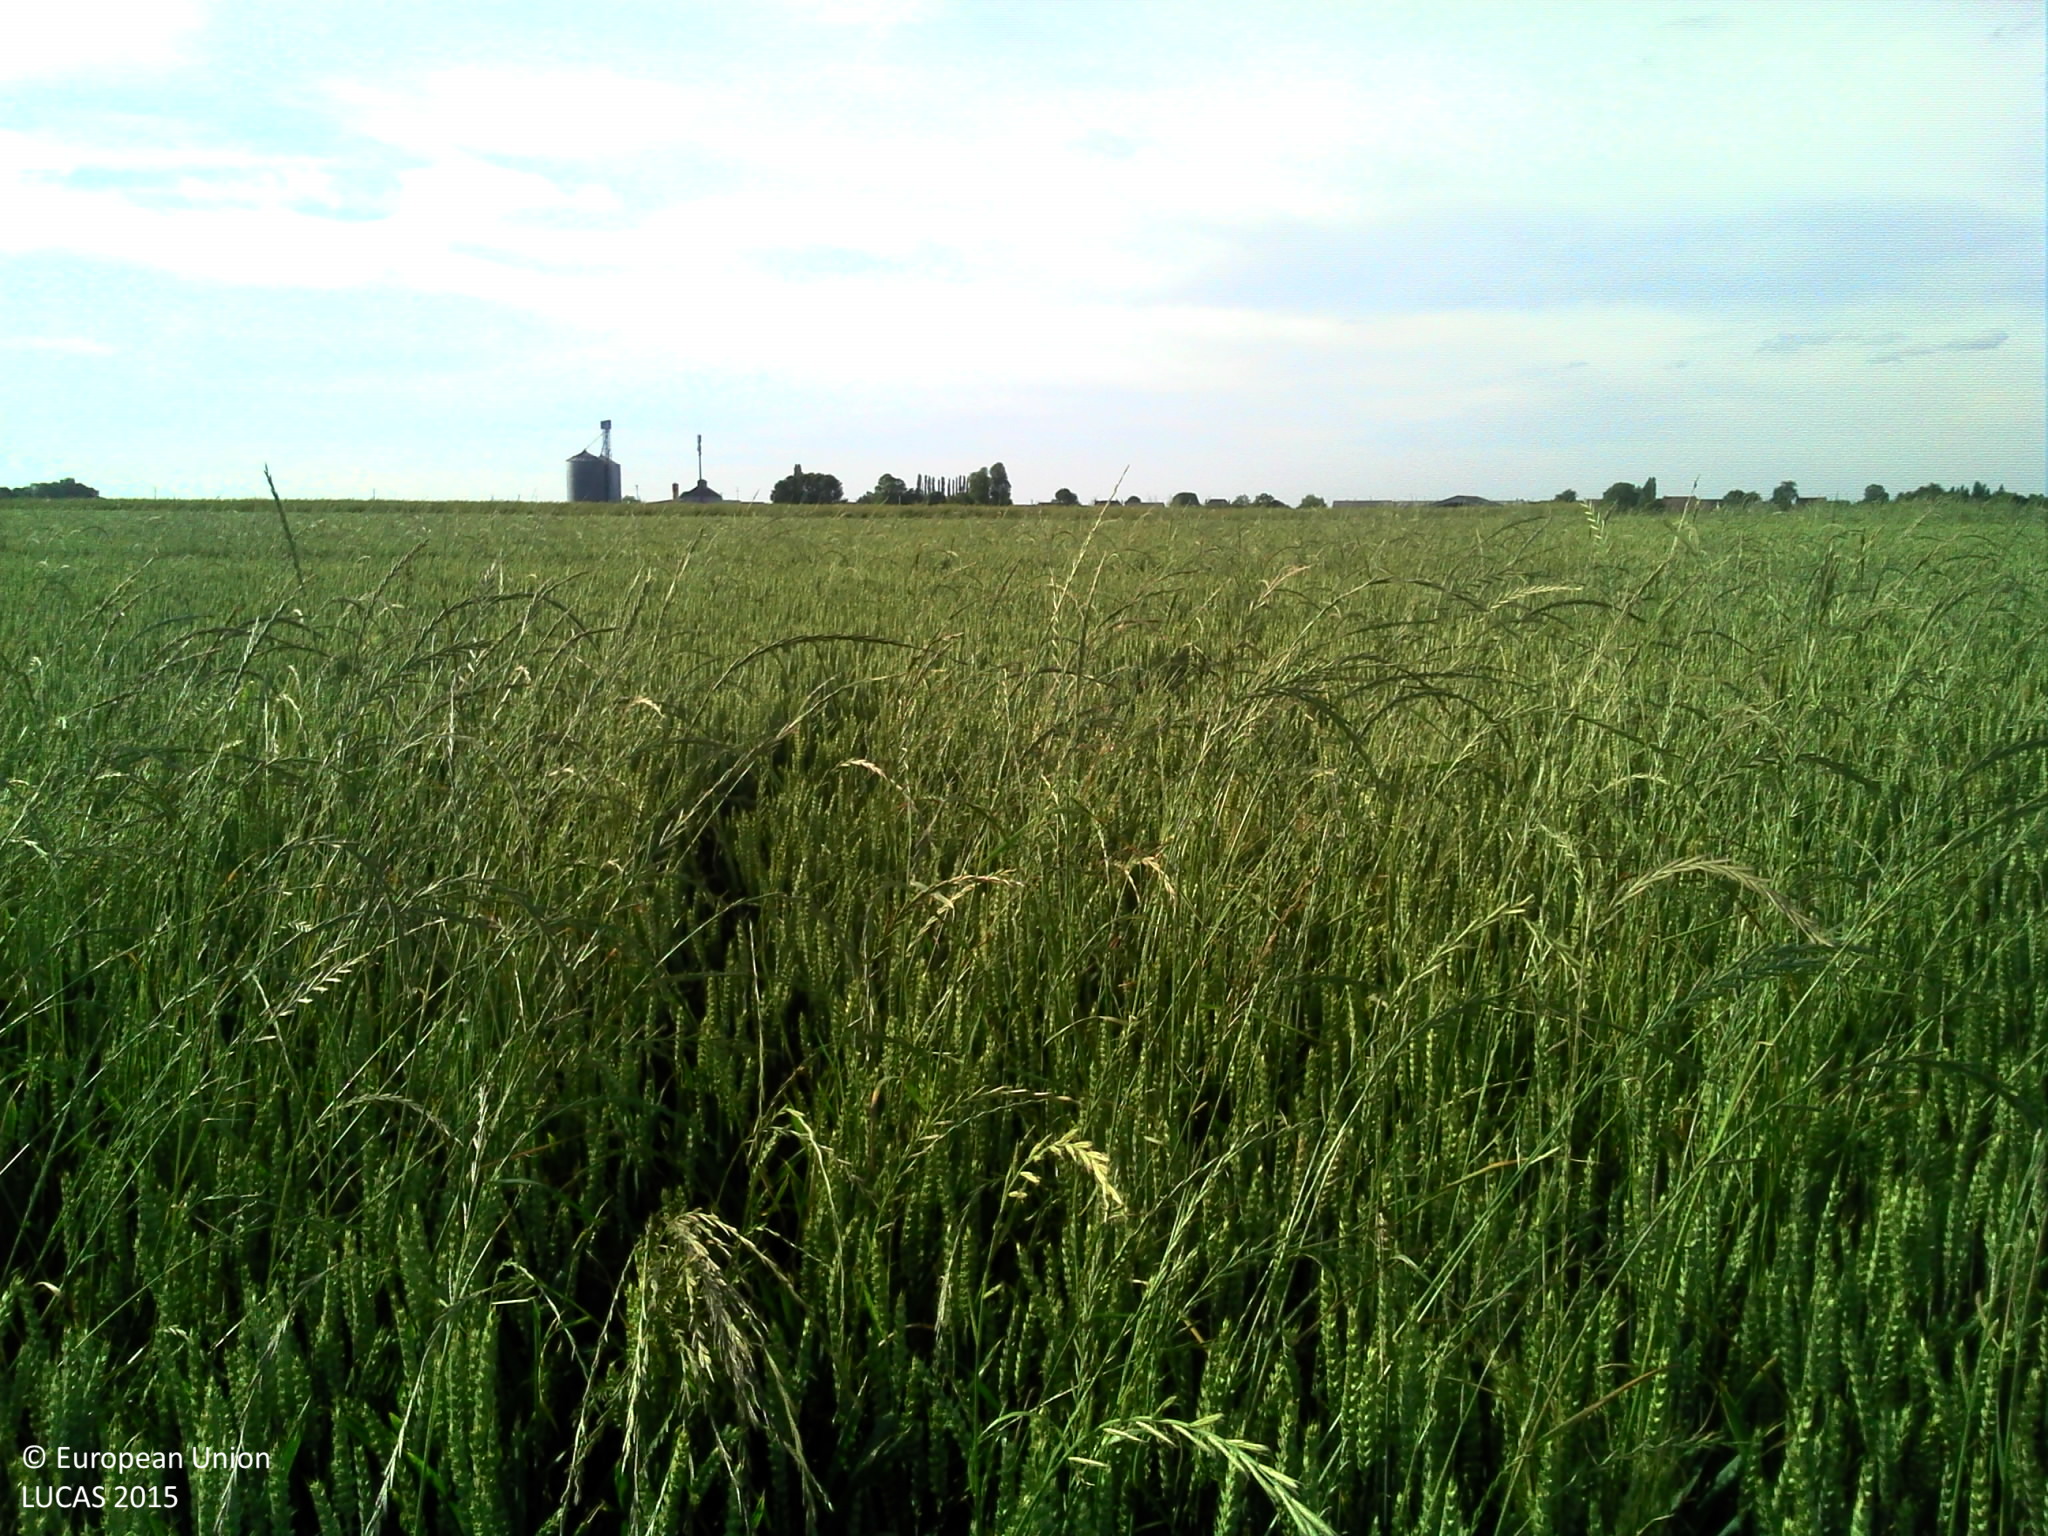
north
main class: Cropland
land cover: Common wheat
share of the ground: > 75 %
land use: Agriculture (excluding fallow land and kitchen gardens)
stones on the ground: < 10 %
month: June
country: FR
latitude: 49.2001
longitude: 1.0718
